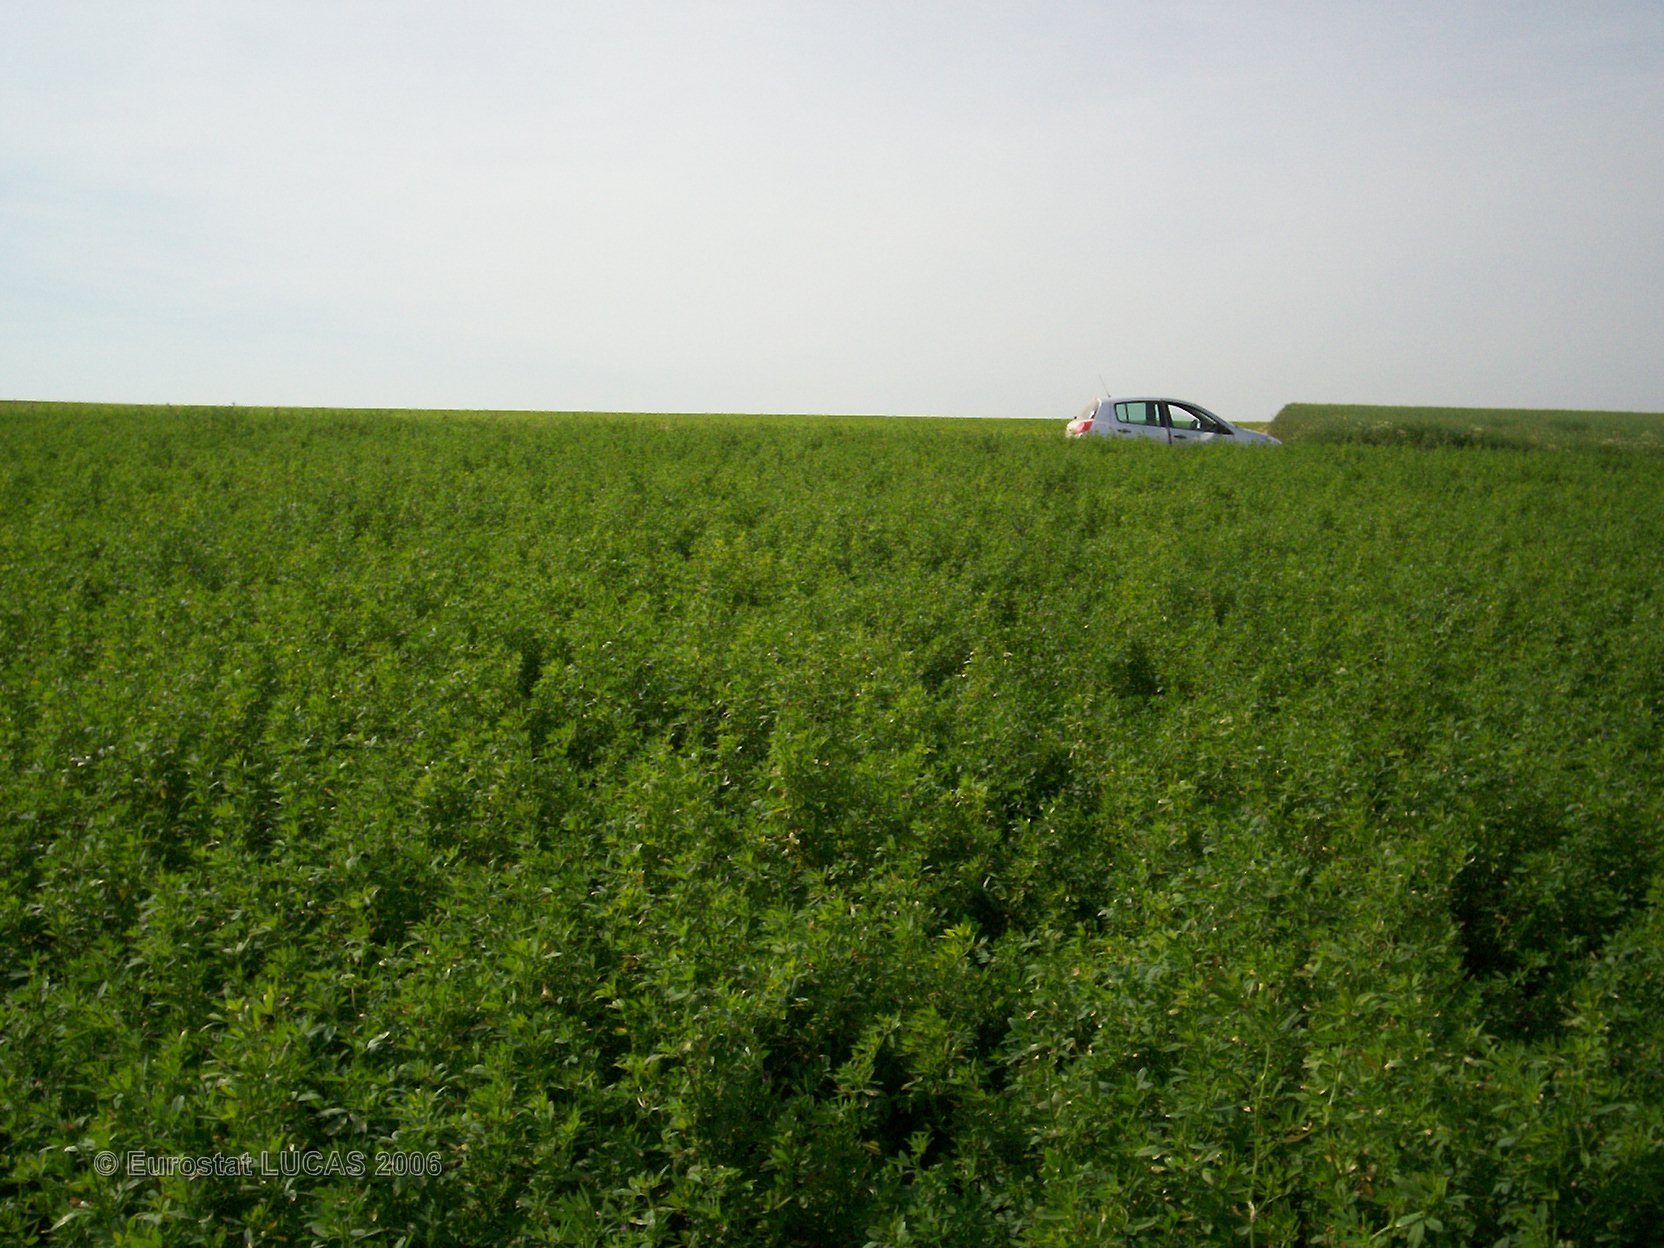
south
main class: Cropland
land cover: Lucerne
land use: Agriculture (excluding fallow land and kitchen gardens)
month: June
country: FR
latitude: 48.9502
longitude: 4.4662
